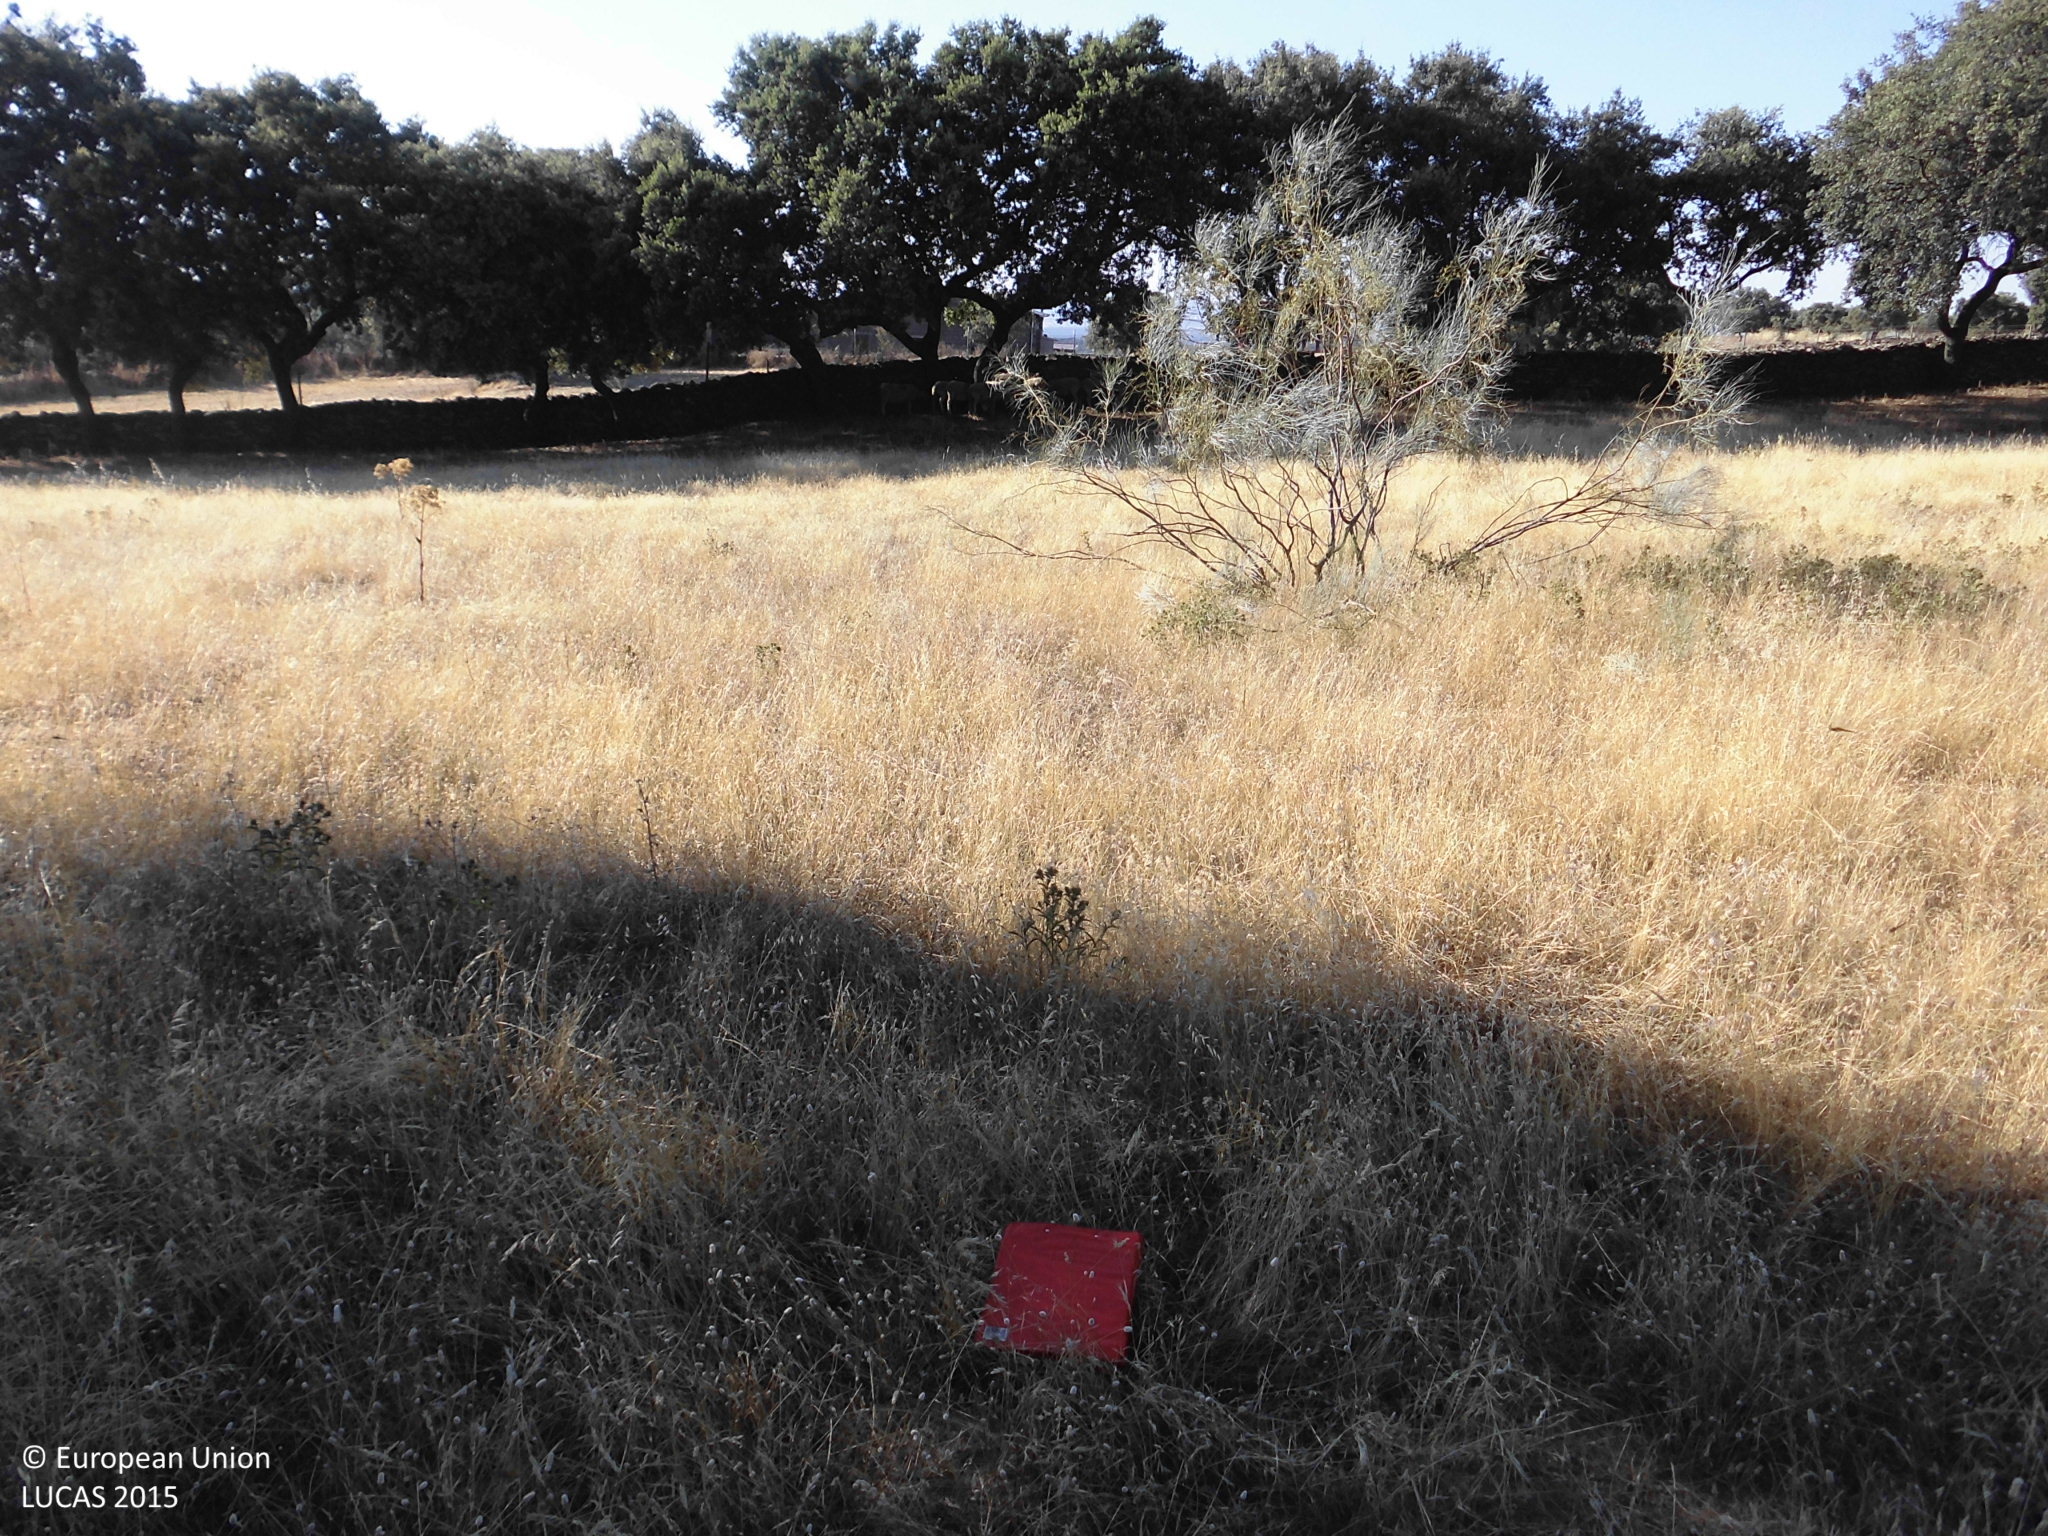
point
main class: Grassland
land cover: Grassland with sparse tree/shrub cover
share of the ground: > 75 %
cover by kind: herbaceous plants 95 %, broadleaved forest trees 5 %
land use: Agriculture (excluding fallow land and kitchen gardens)
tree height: > 5 m
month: July
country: ES
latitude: 39.5208
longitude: -5.6304
